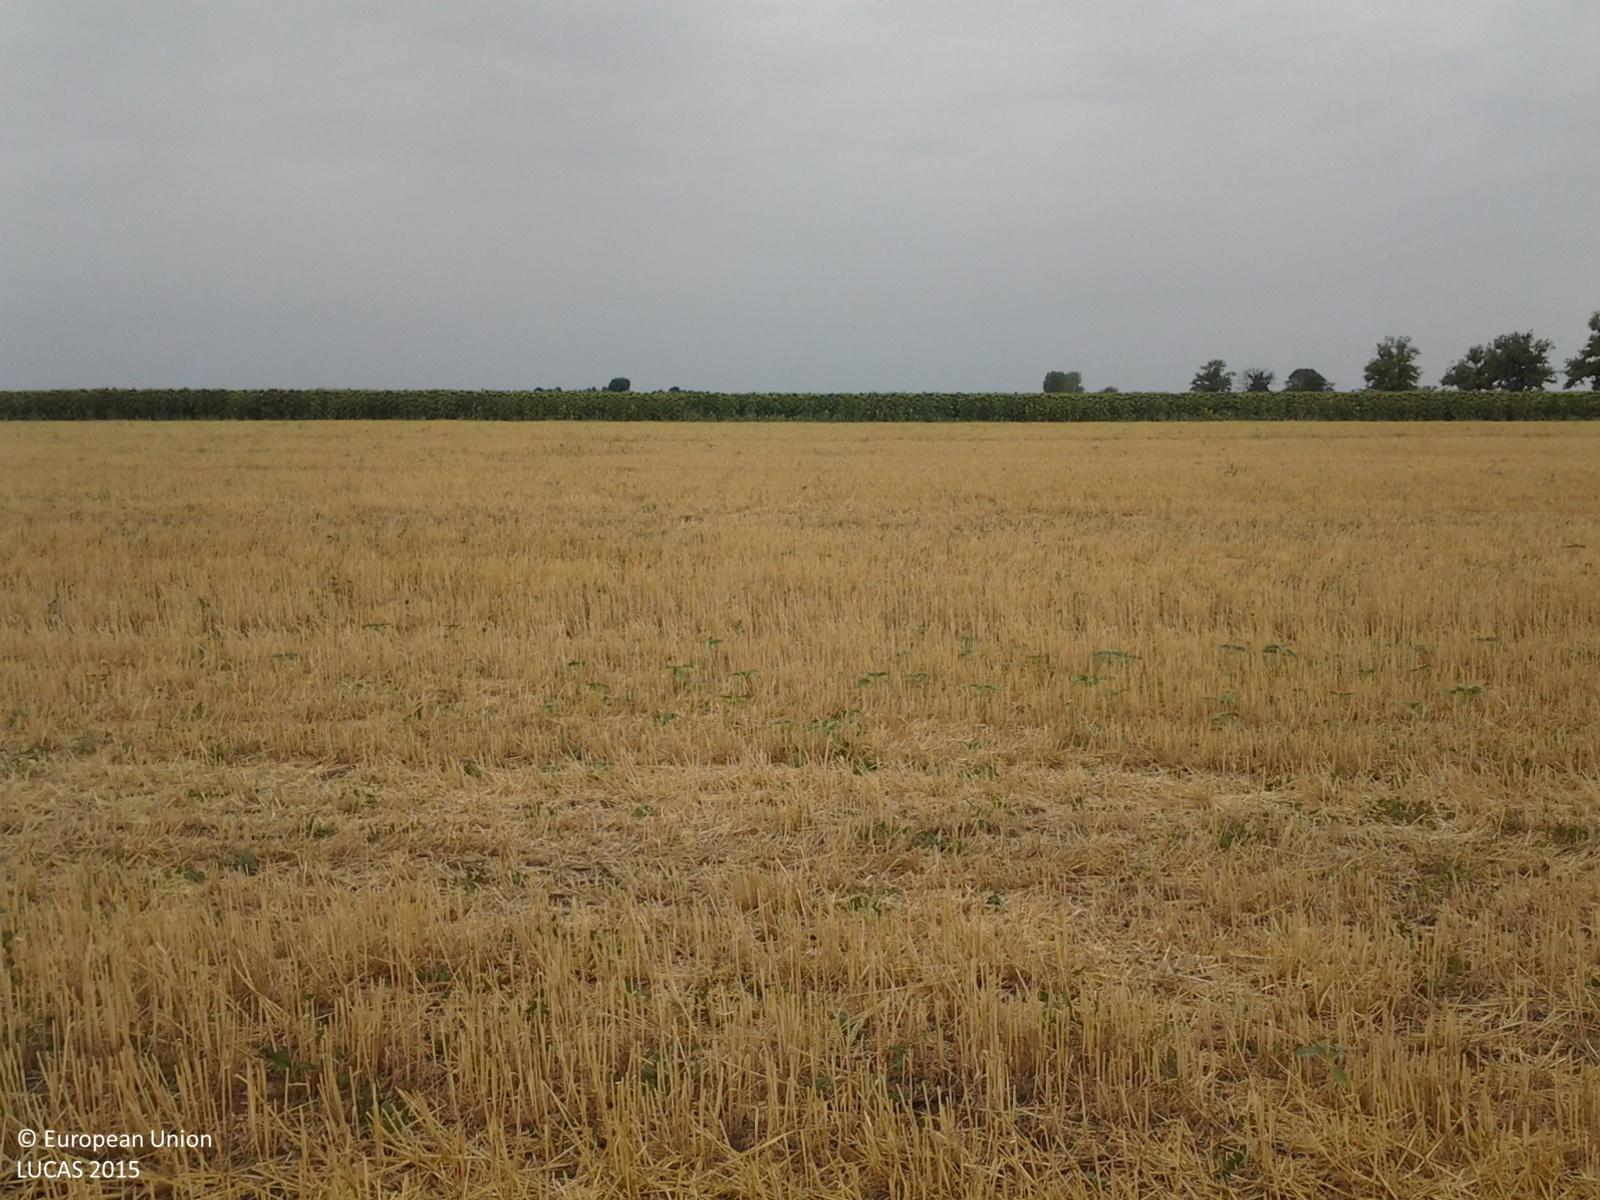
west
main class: Cropland
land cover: Common wheat
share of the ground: < 10 %
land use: Agriculture (excluding fallow land and kitchen gardens)
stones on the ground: < 10 %
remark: Harvested field
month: July
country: HU
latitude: 47.2883
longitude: 20.8364
